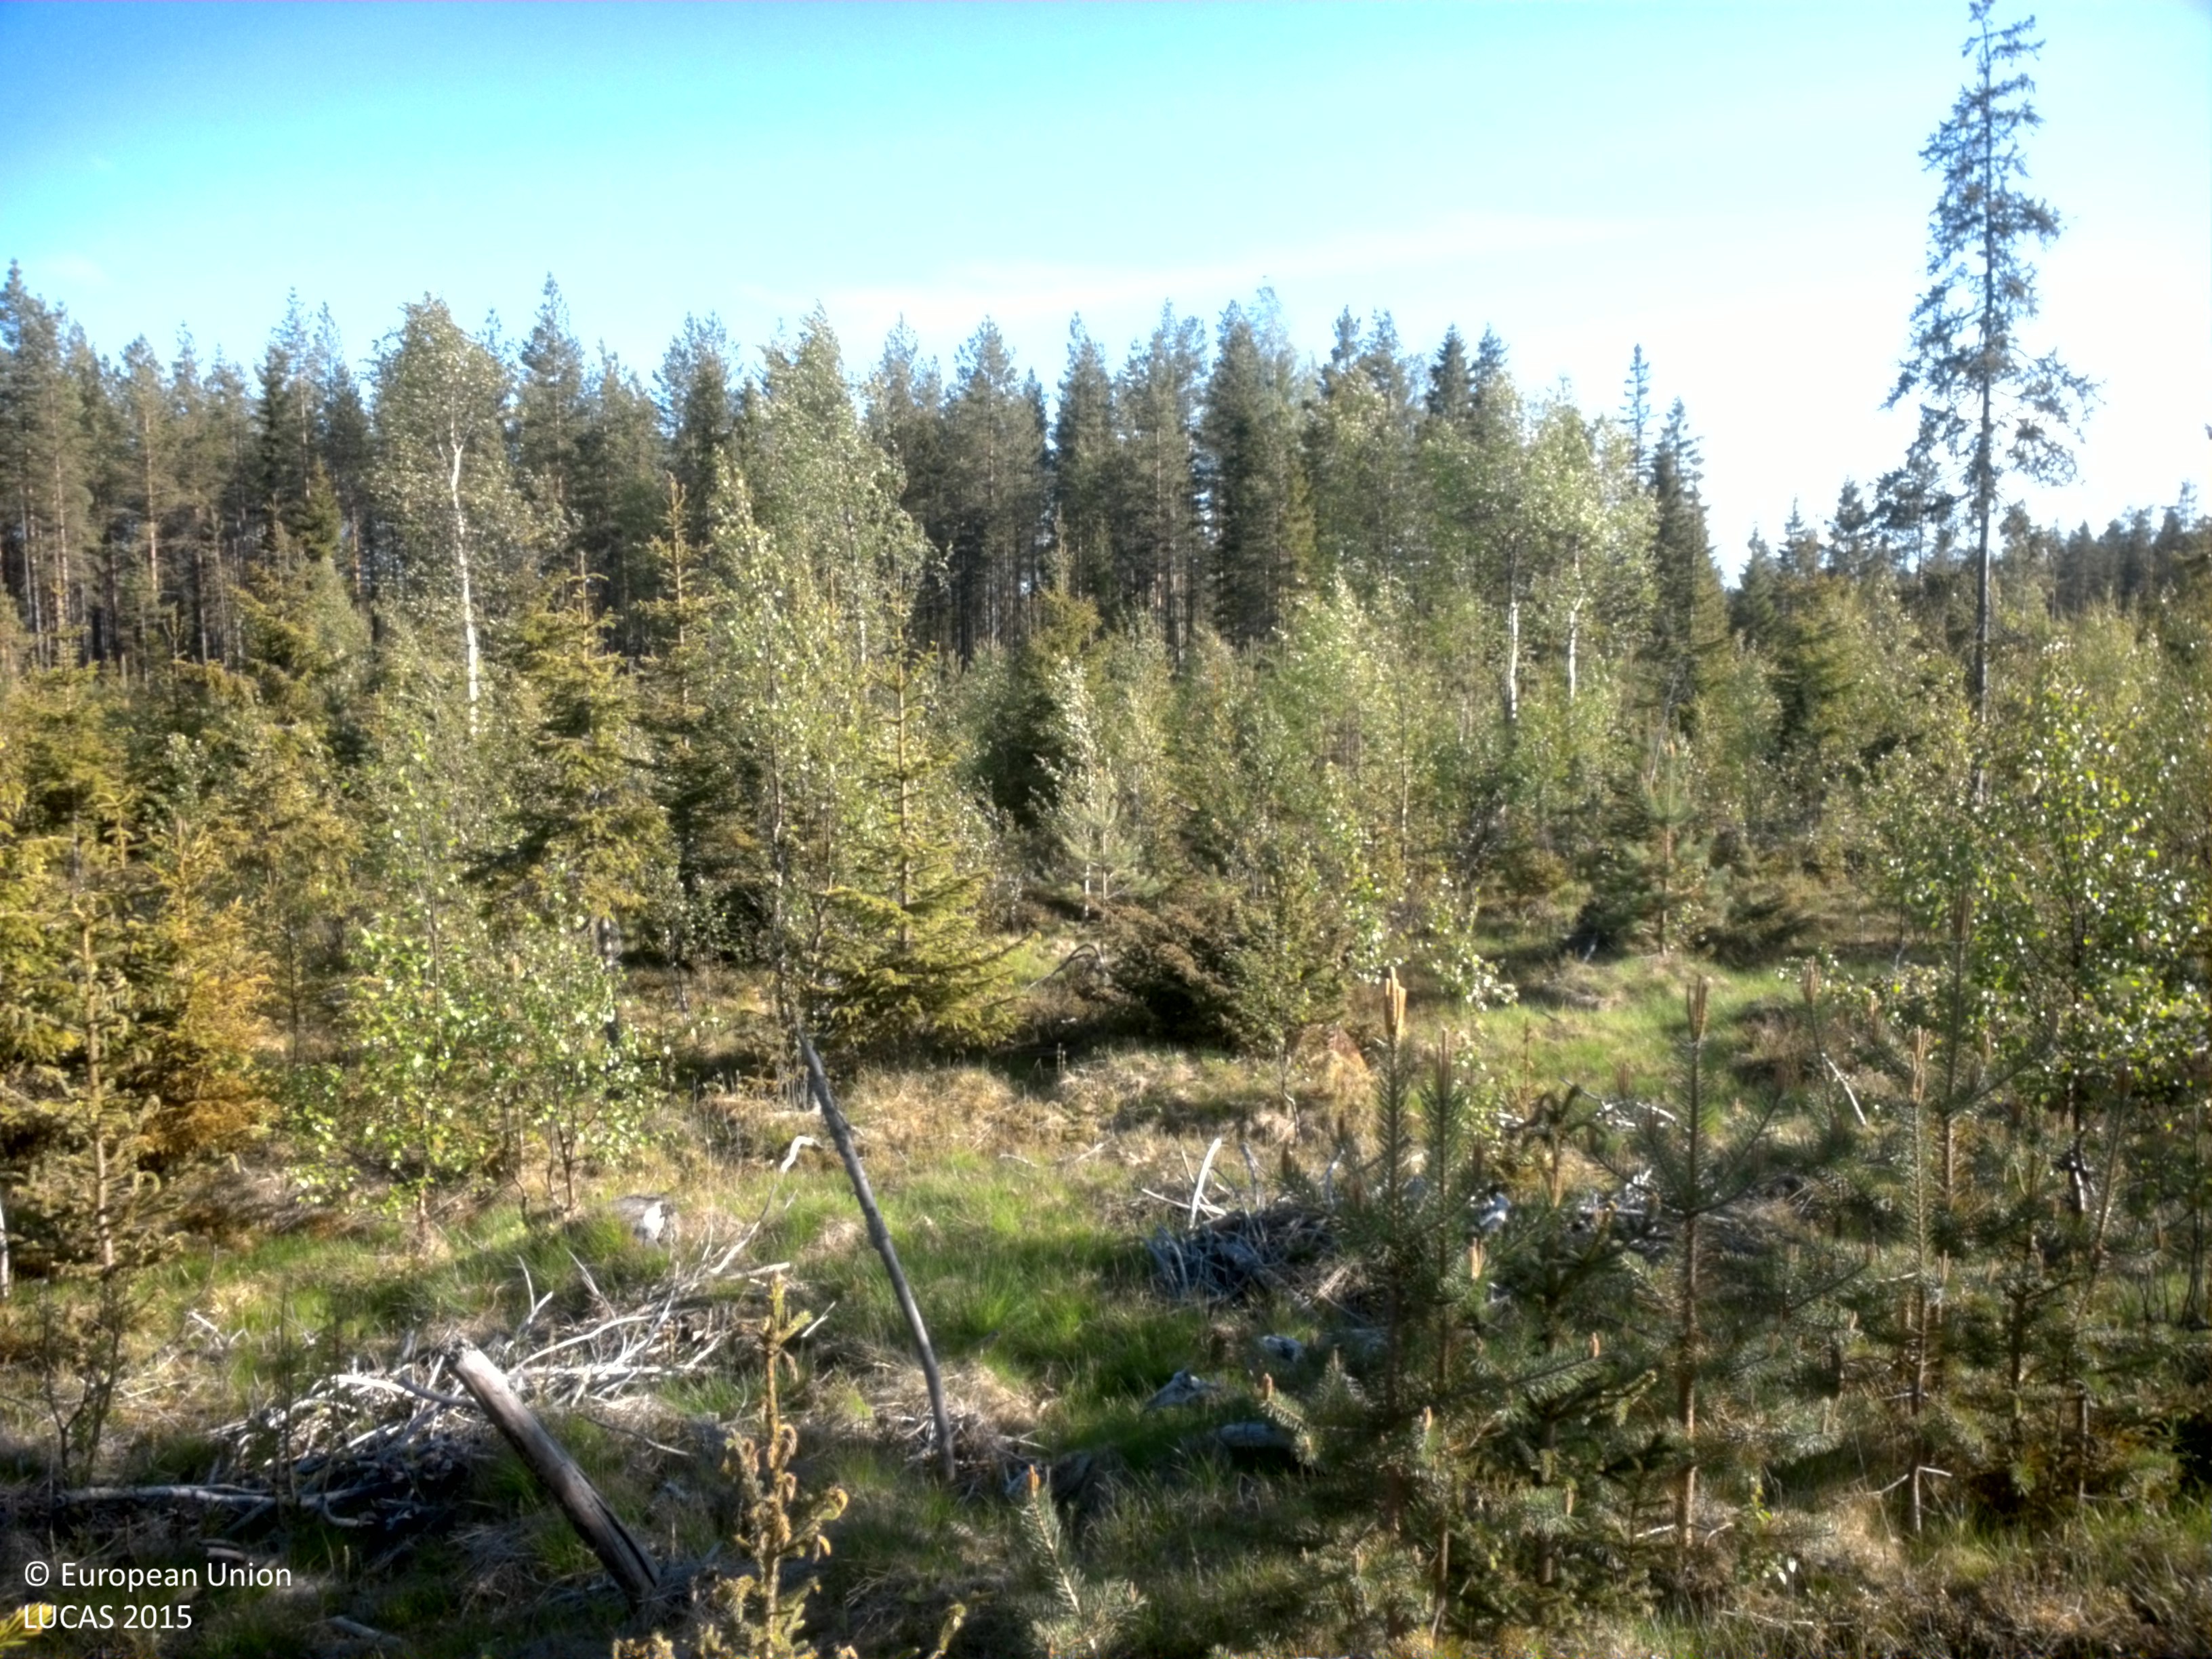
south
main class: Woodland
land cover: Other mixed woodland
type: boreal forest
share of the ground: 25 - 50 %
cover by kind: herbaceous plants 40 %, coniferous forest trees 30 %, broadleaved forest trees 20 %, shrubs 10 %
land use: Forestry
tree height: < 5 m
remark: Clear cut
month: June
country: SE
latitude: 63.9841
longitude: 20.3822
